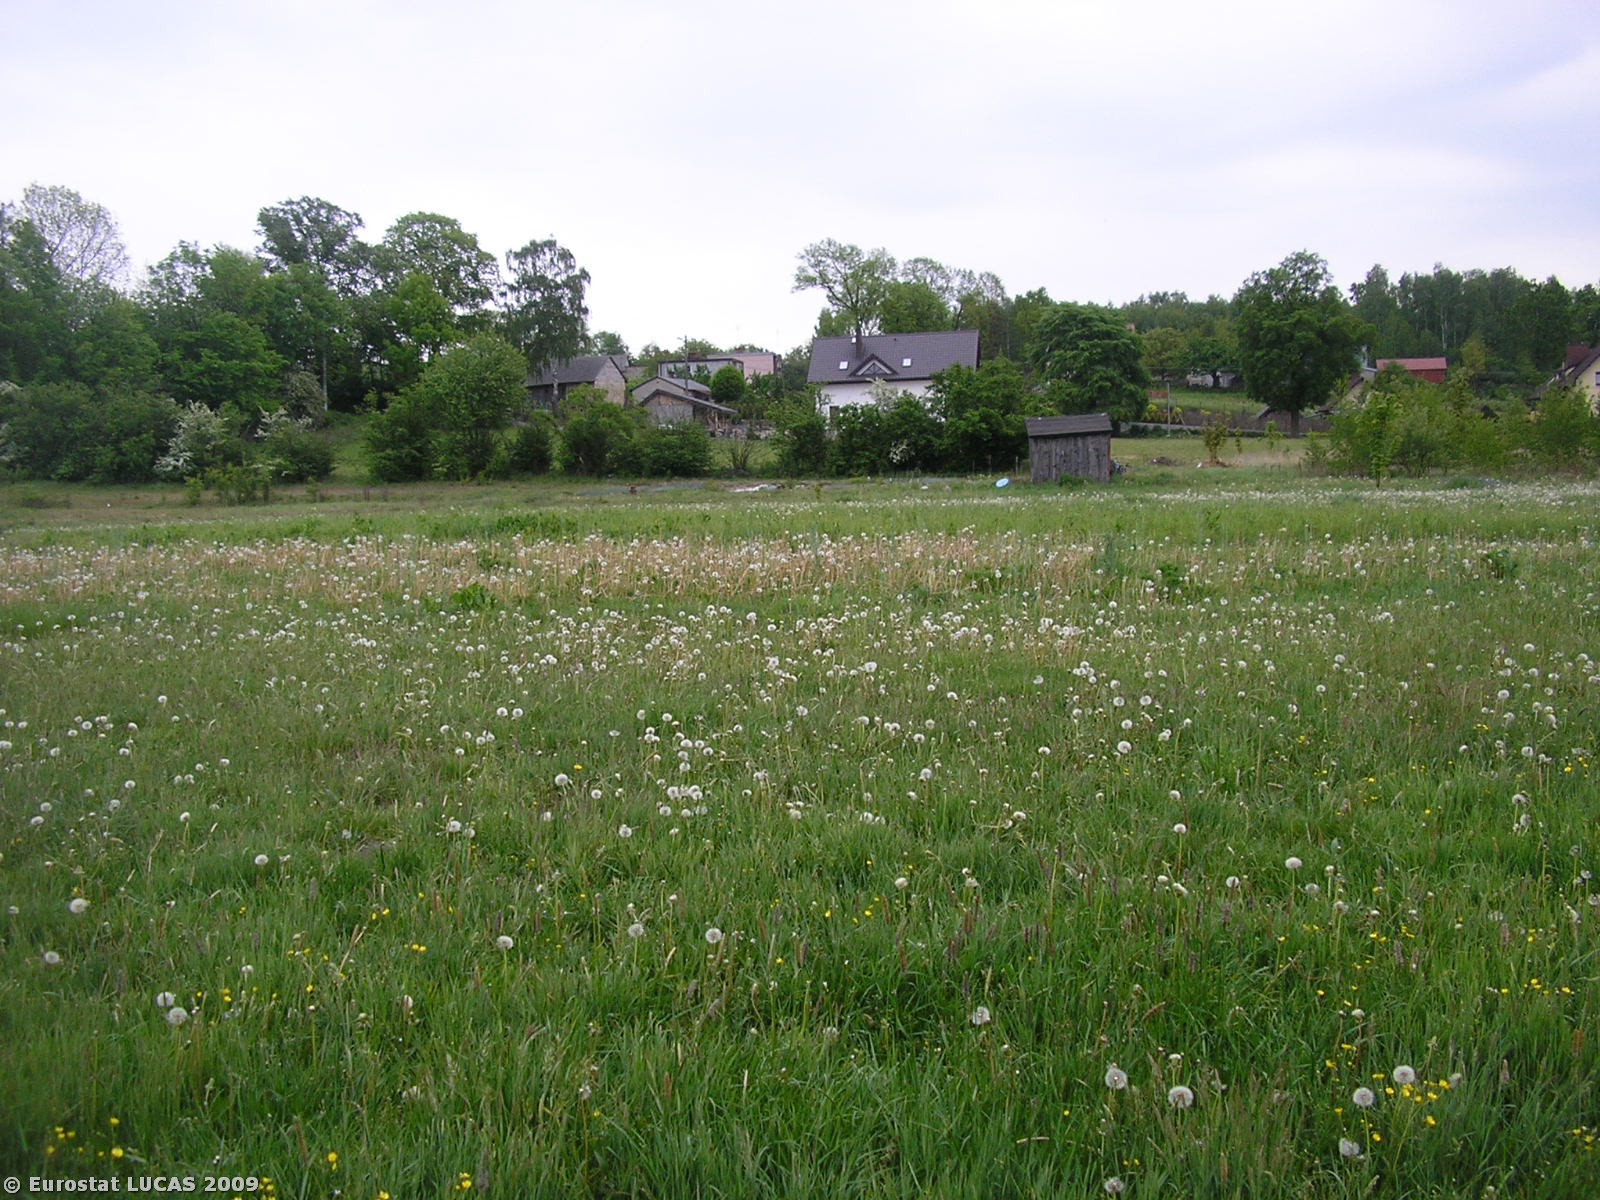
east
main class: Grassland
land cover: Grassland without tree/shrub cover
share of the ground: > 75 %
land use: Agriculture (excluding fallow land and kitchen gardens)
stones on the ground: < 10 %
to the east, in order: Grassland without tree/shrub cover; Abandoned hedges; Grassland without tree/shrub cover; Abandoned hedges; Paved roads, cycling and walking lanes; Fences; Electric lines; Artificial constructions in urban areas; Fences; Electric lines; Paved roads, cycling and walking lanes; Fences; Apple fruit; Fences; Artificial constructions in urban areas
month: May
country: PL
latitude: 51.4821
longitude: 20.0121
